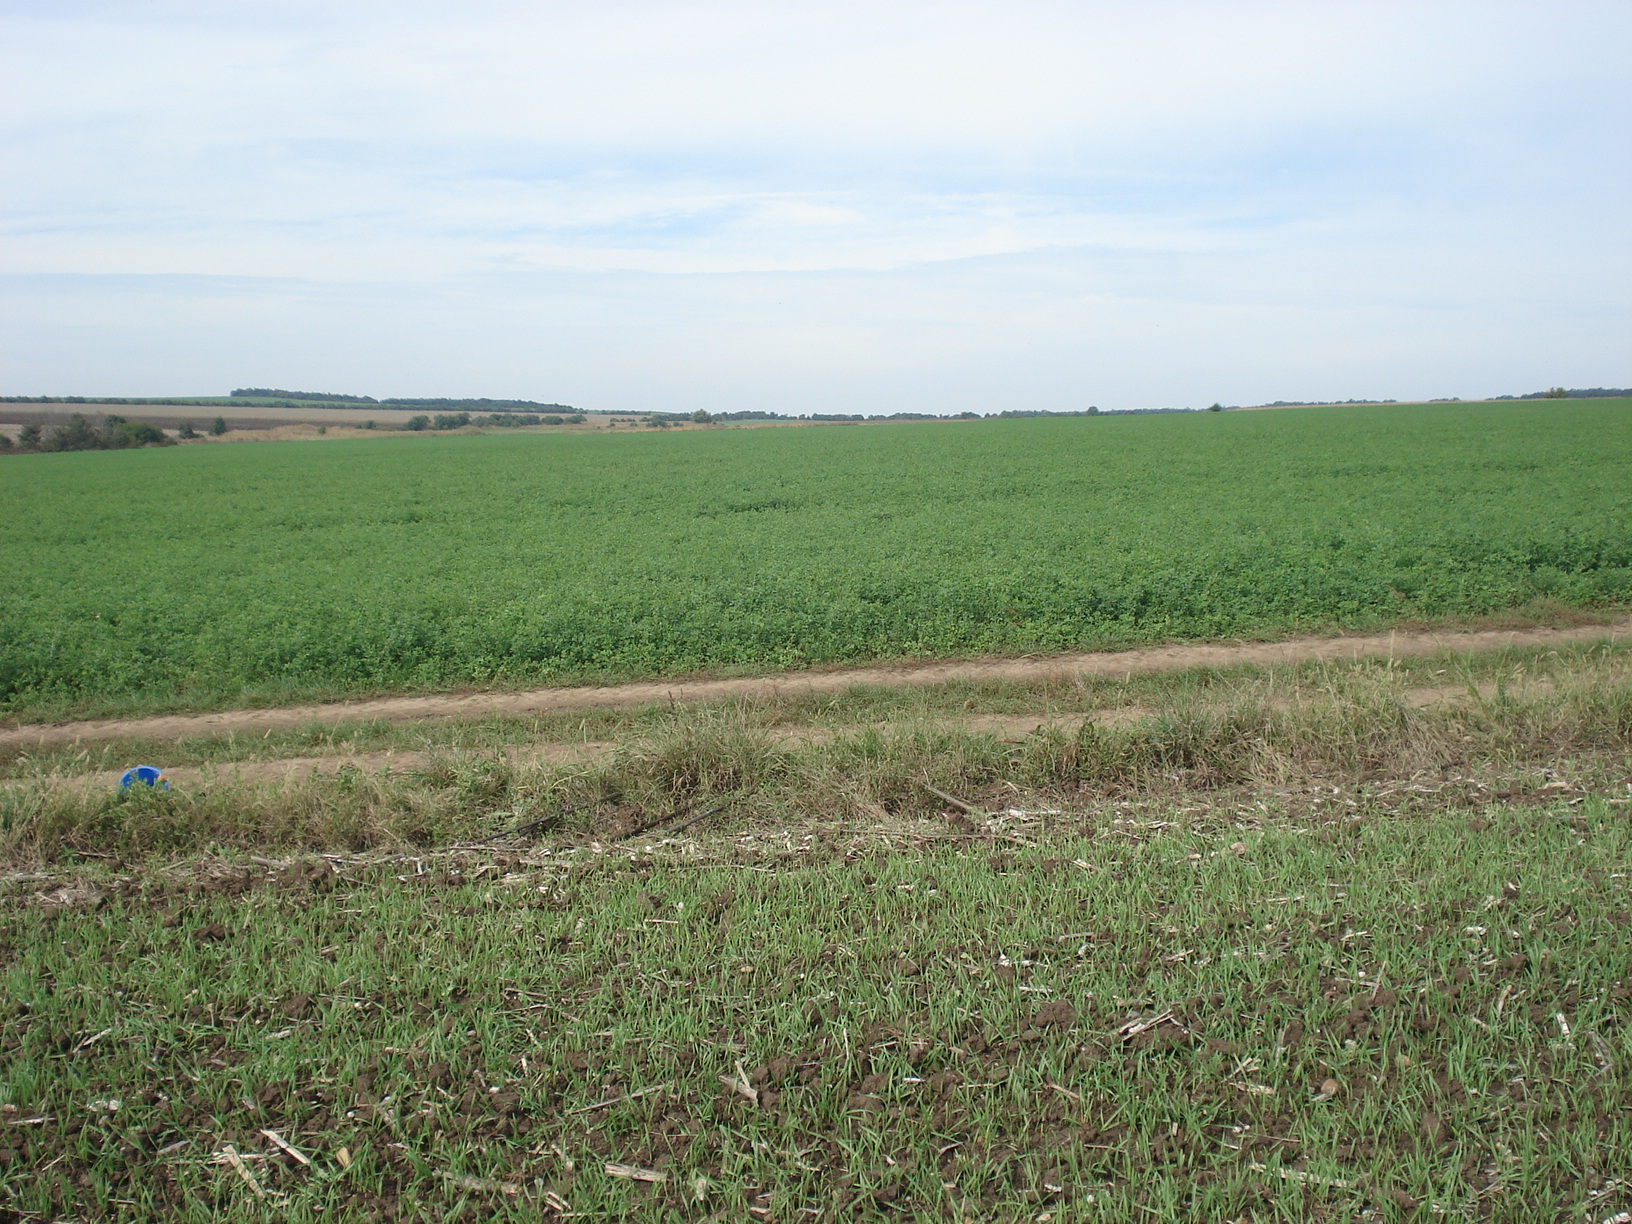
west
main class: Cropland
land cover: Common wheat
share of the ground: 25 - 50 %
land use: Agriculture (excluding fallow land and kitchen gardens)
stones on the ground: < 10 %
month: October
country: BG
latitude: 43.3064
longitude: 25.3761
